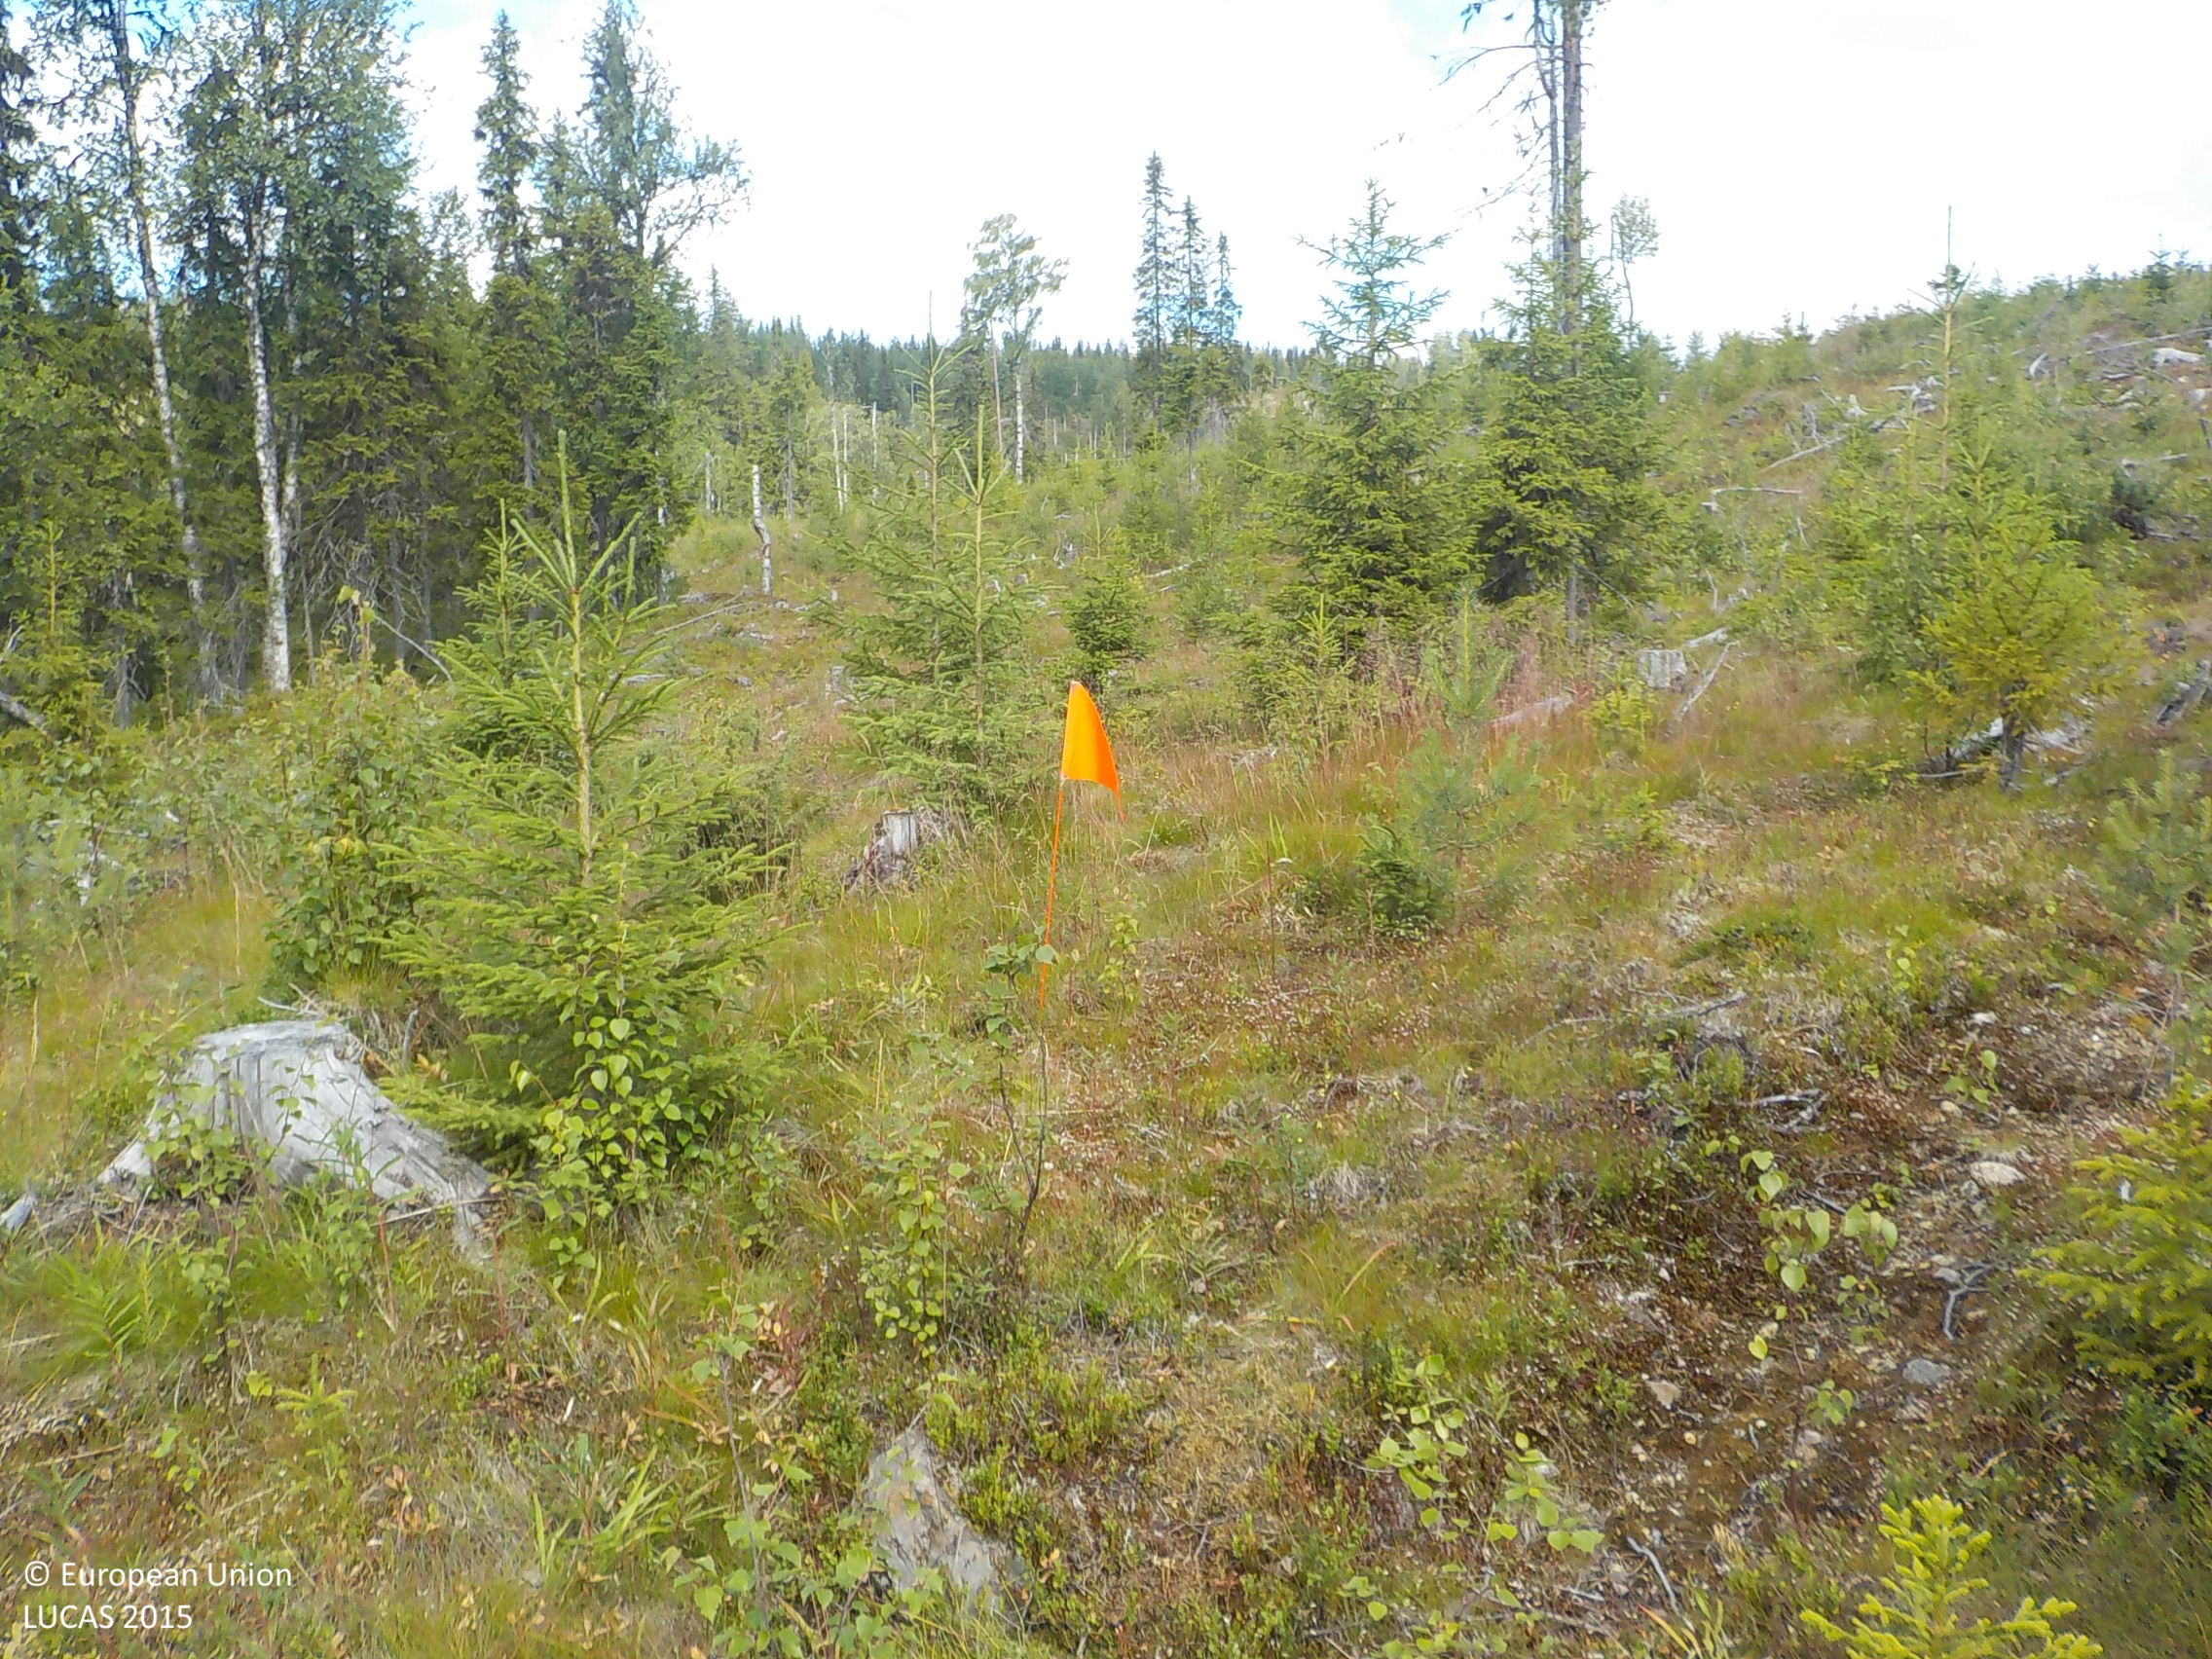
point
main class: Woodland
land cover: Spruce dominated mixed woodland
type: boreal forest
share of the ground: 25 - 50 %
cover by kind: herbaceous plants 60 %, coniferous forest trees 20 %, broadleaved forest trees 10 %, shrubs 5 %, lichens and mosses 5 %
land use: Forestry
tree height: < 5 m
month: August
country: SE
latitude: 64.1238
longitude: 17.6301
